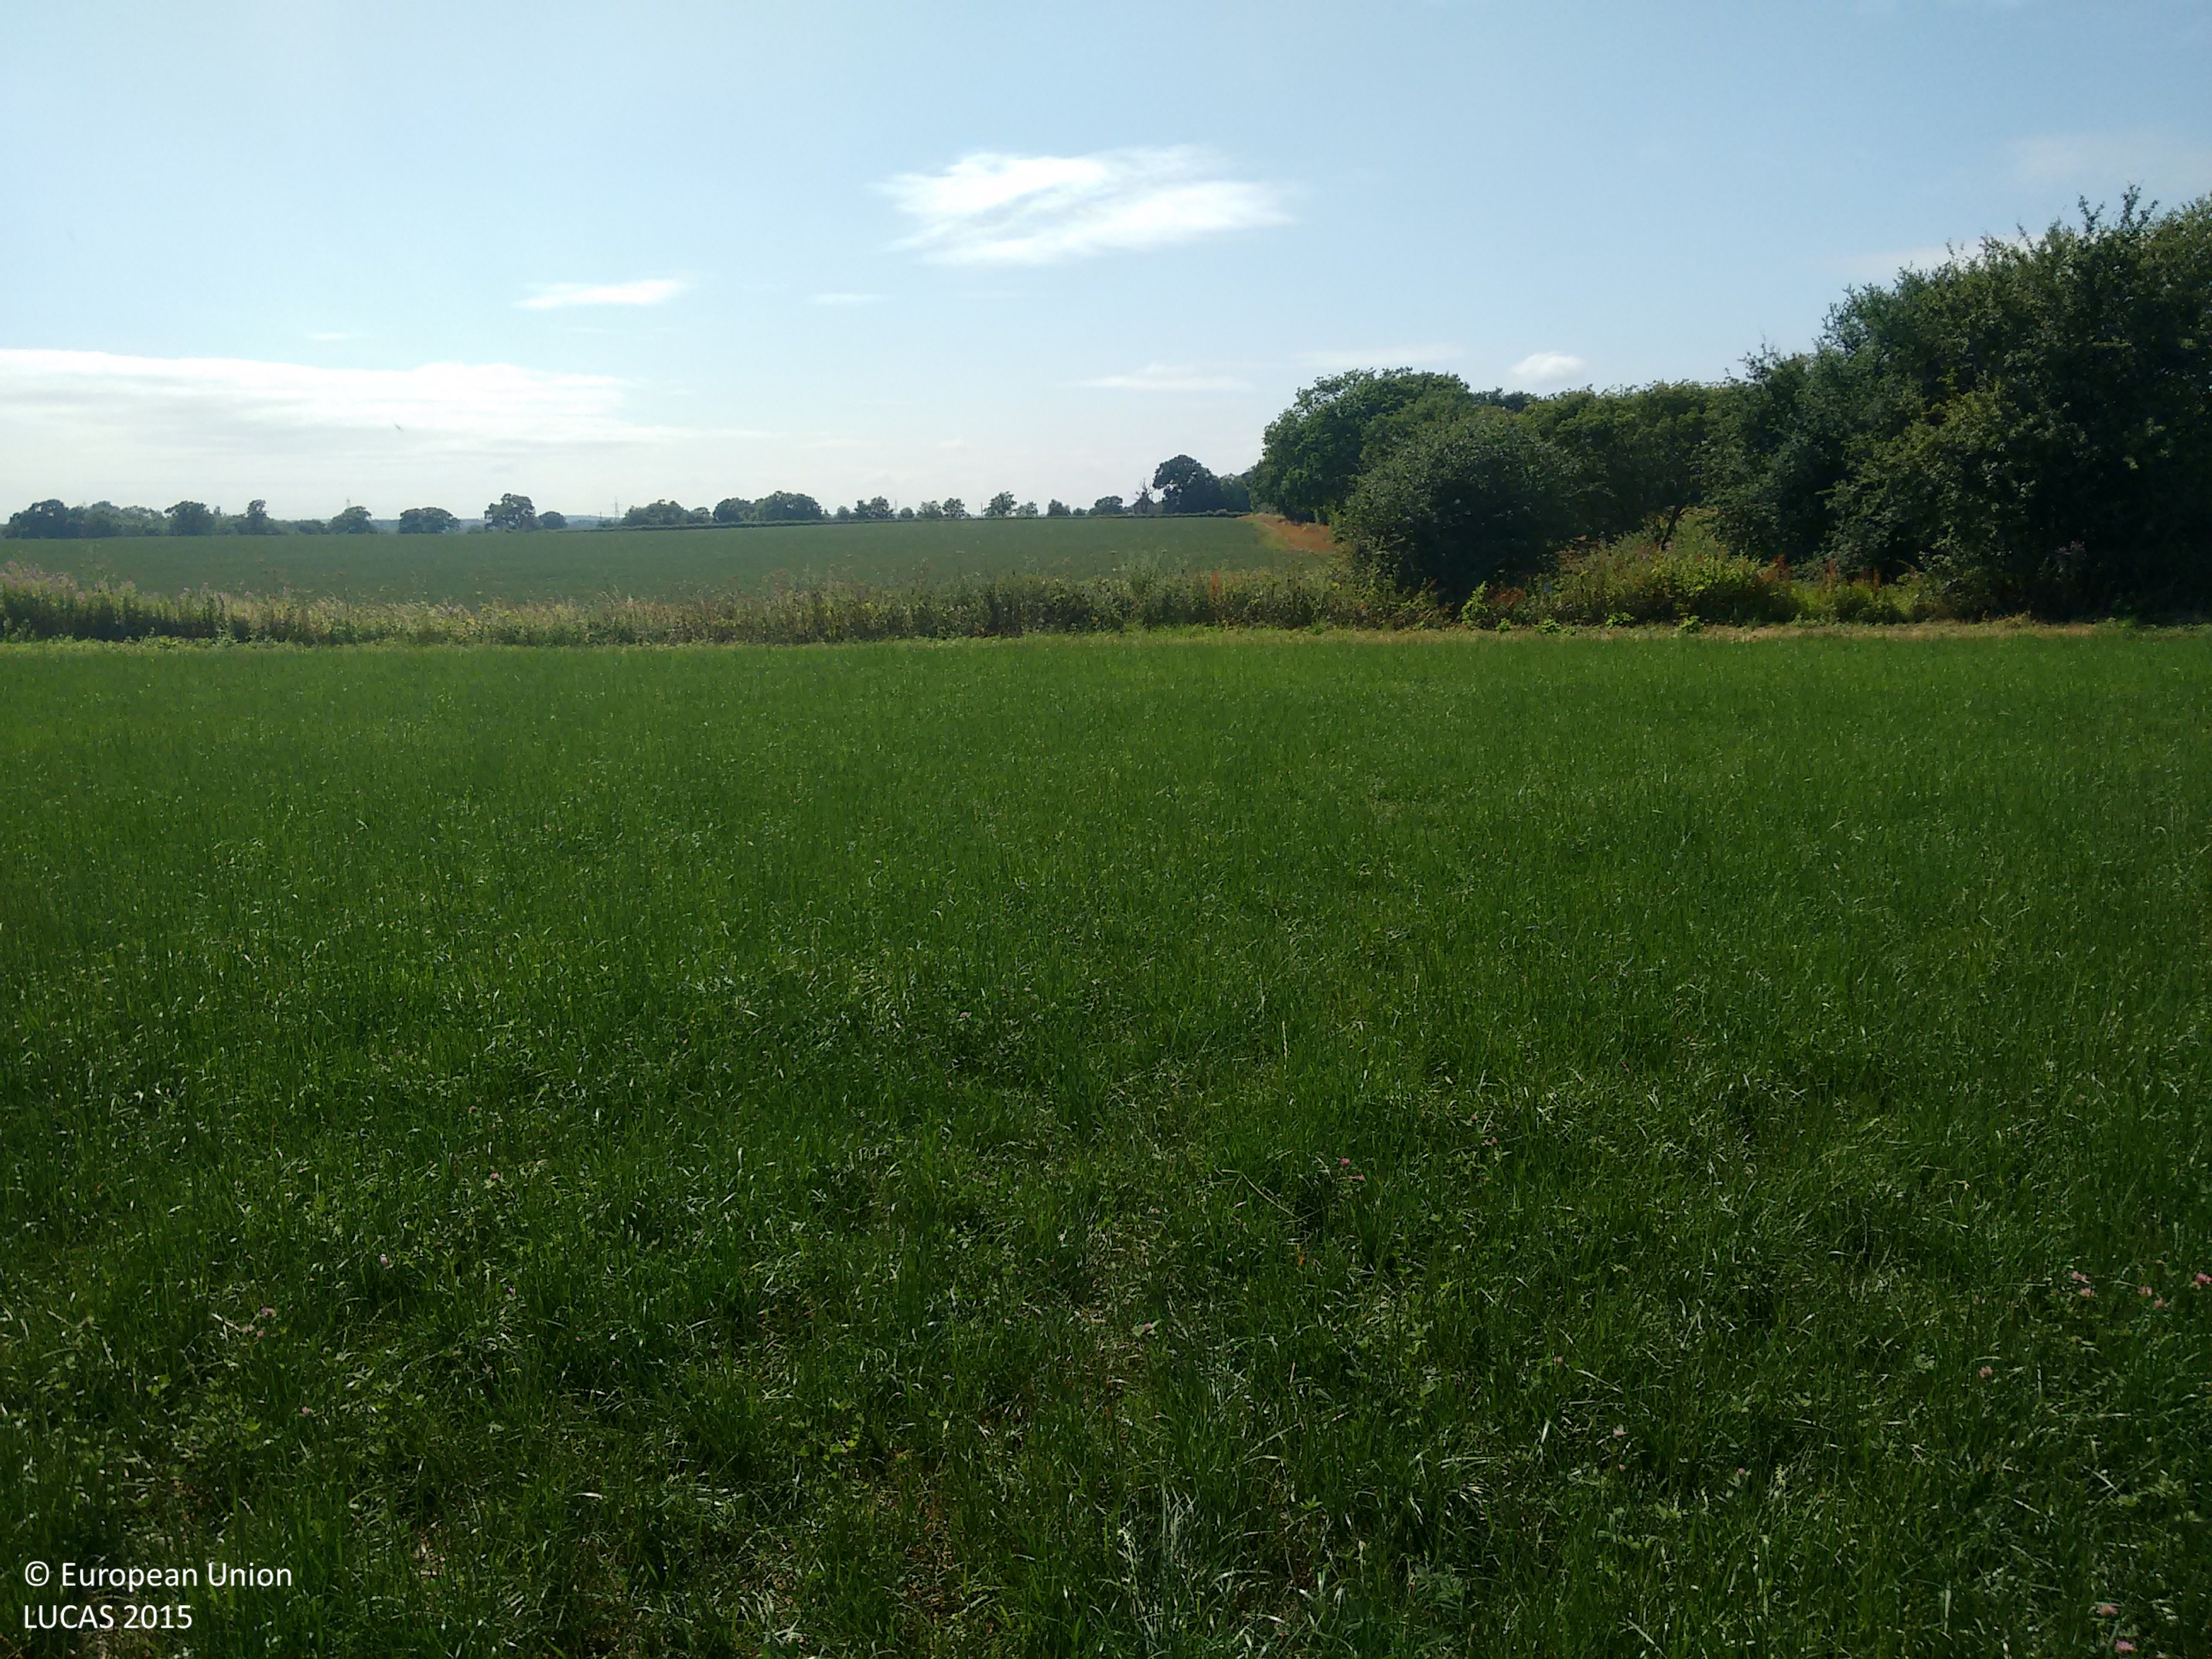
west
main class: Cropland
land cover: Temporary grasslands
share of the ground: > 75 %
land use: Agriculture (excluding fallow land and kitchen gardens)
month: July
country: GB
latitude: 51.6746
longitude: 0.5586
